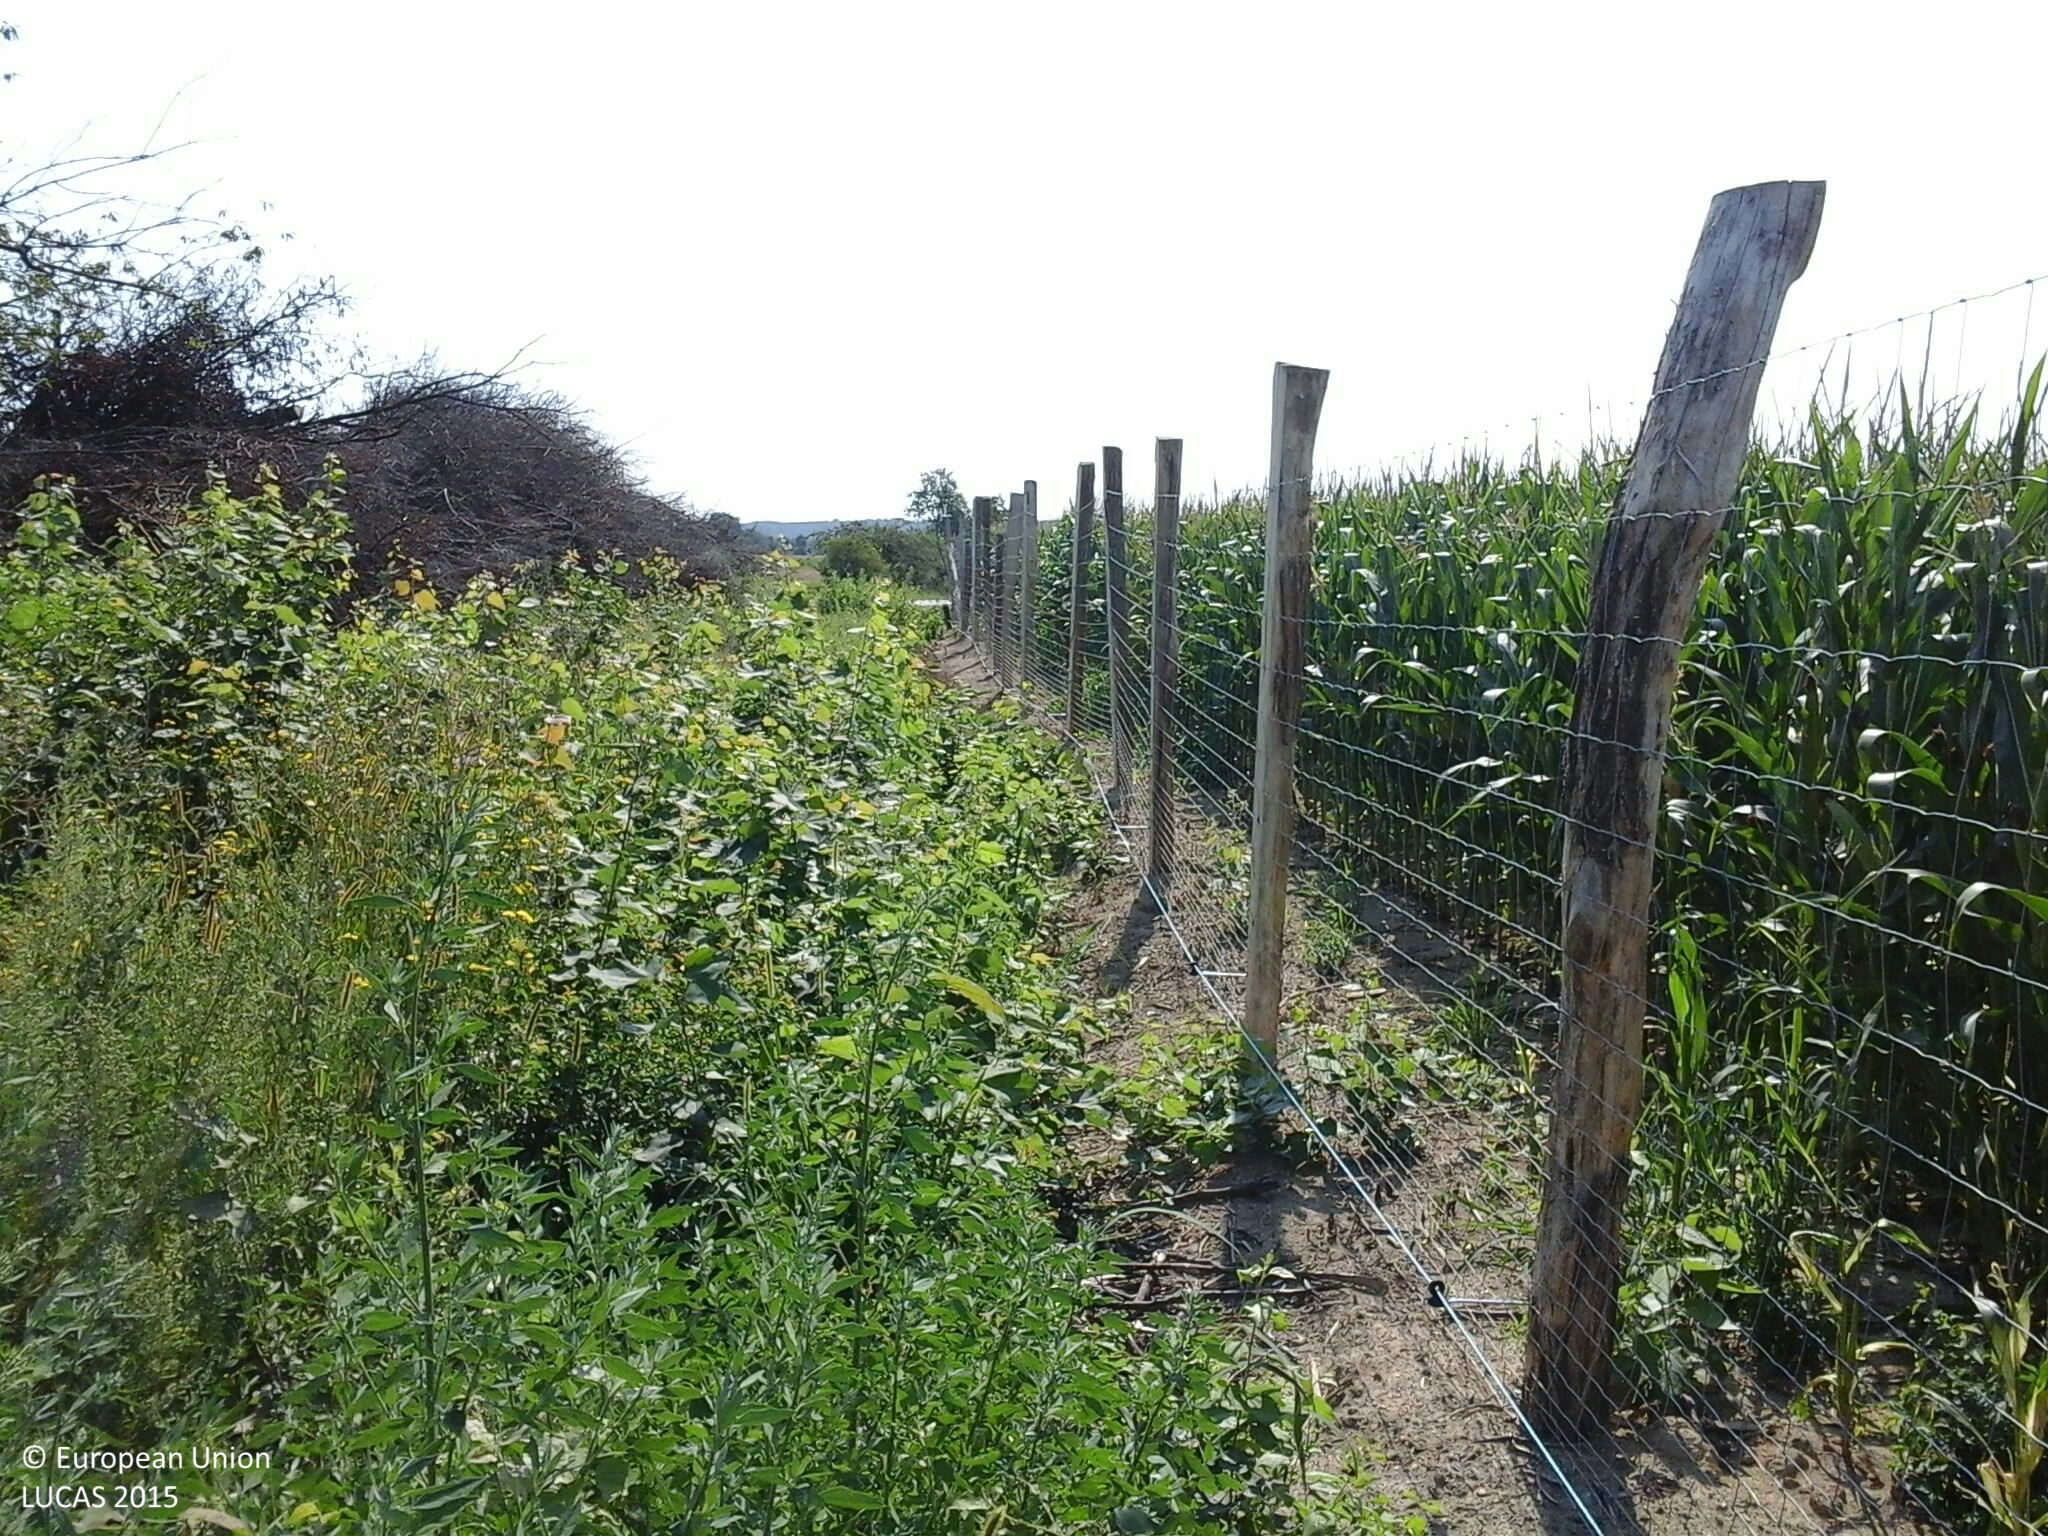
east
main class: Cropland
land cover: Maize
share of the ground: > 75 %
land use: Agriculture (excluding fallow land and kitchen gardens)
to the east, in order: Maize; Fences; Grass margins; Ditches and canals; Grass margins; Paved roads, cycling and walking lanes; Grass margins; Ditches and canals; Fences; Other fresh vegetables; Fences; Abandoned hedges; Ditches and canals; Shruby margins; Common wheat
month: July
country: HU
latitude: 46.6743
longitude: 16.5509
